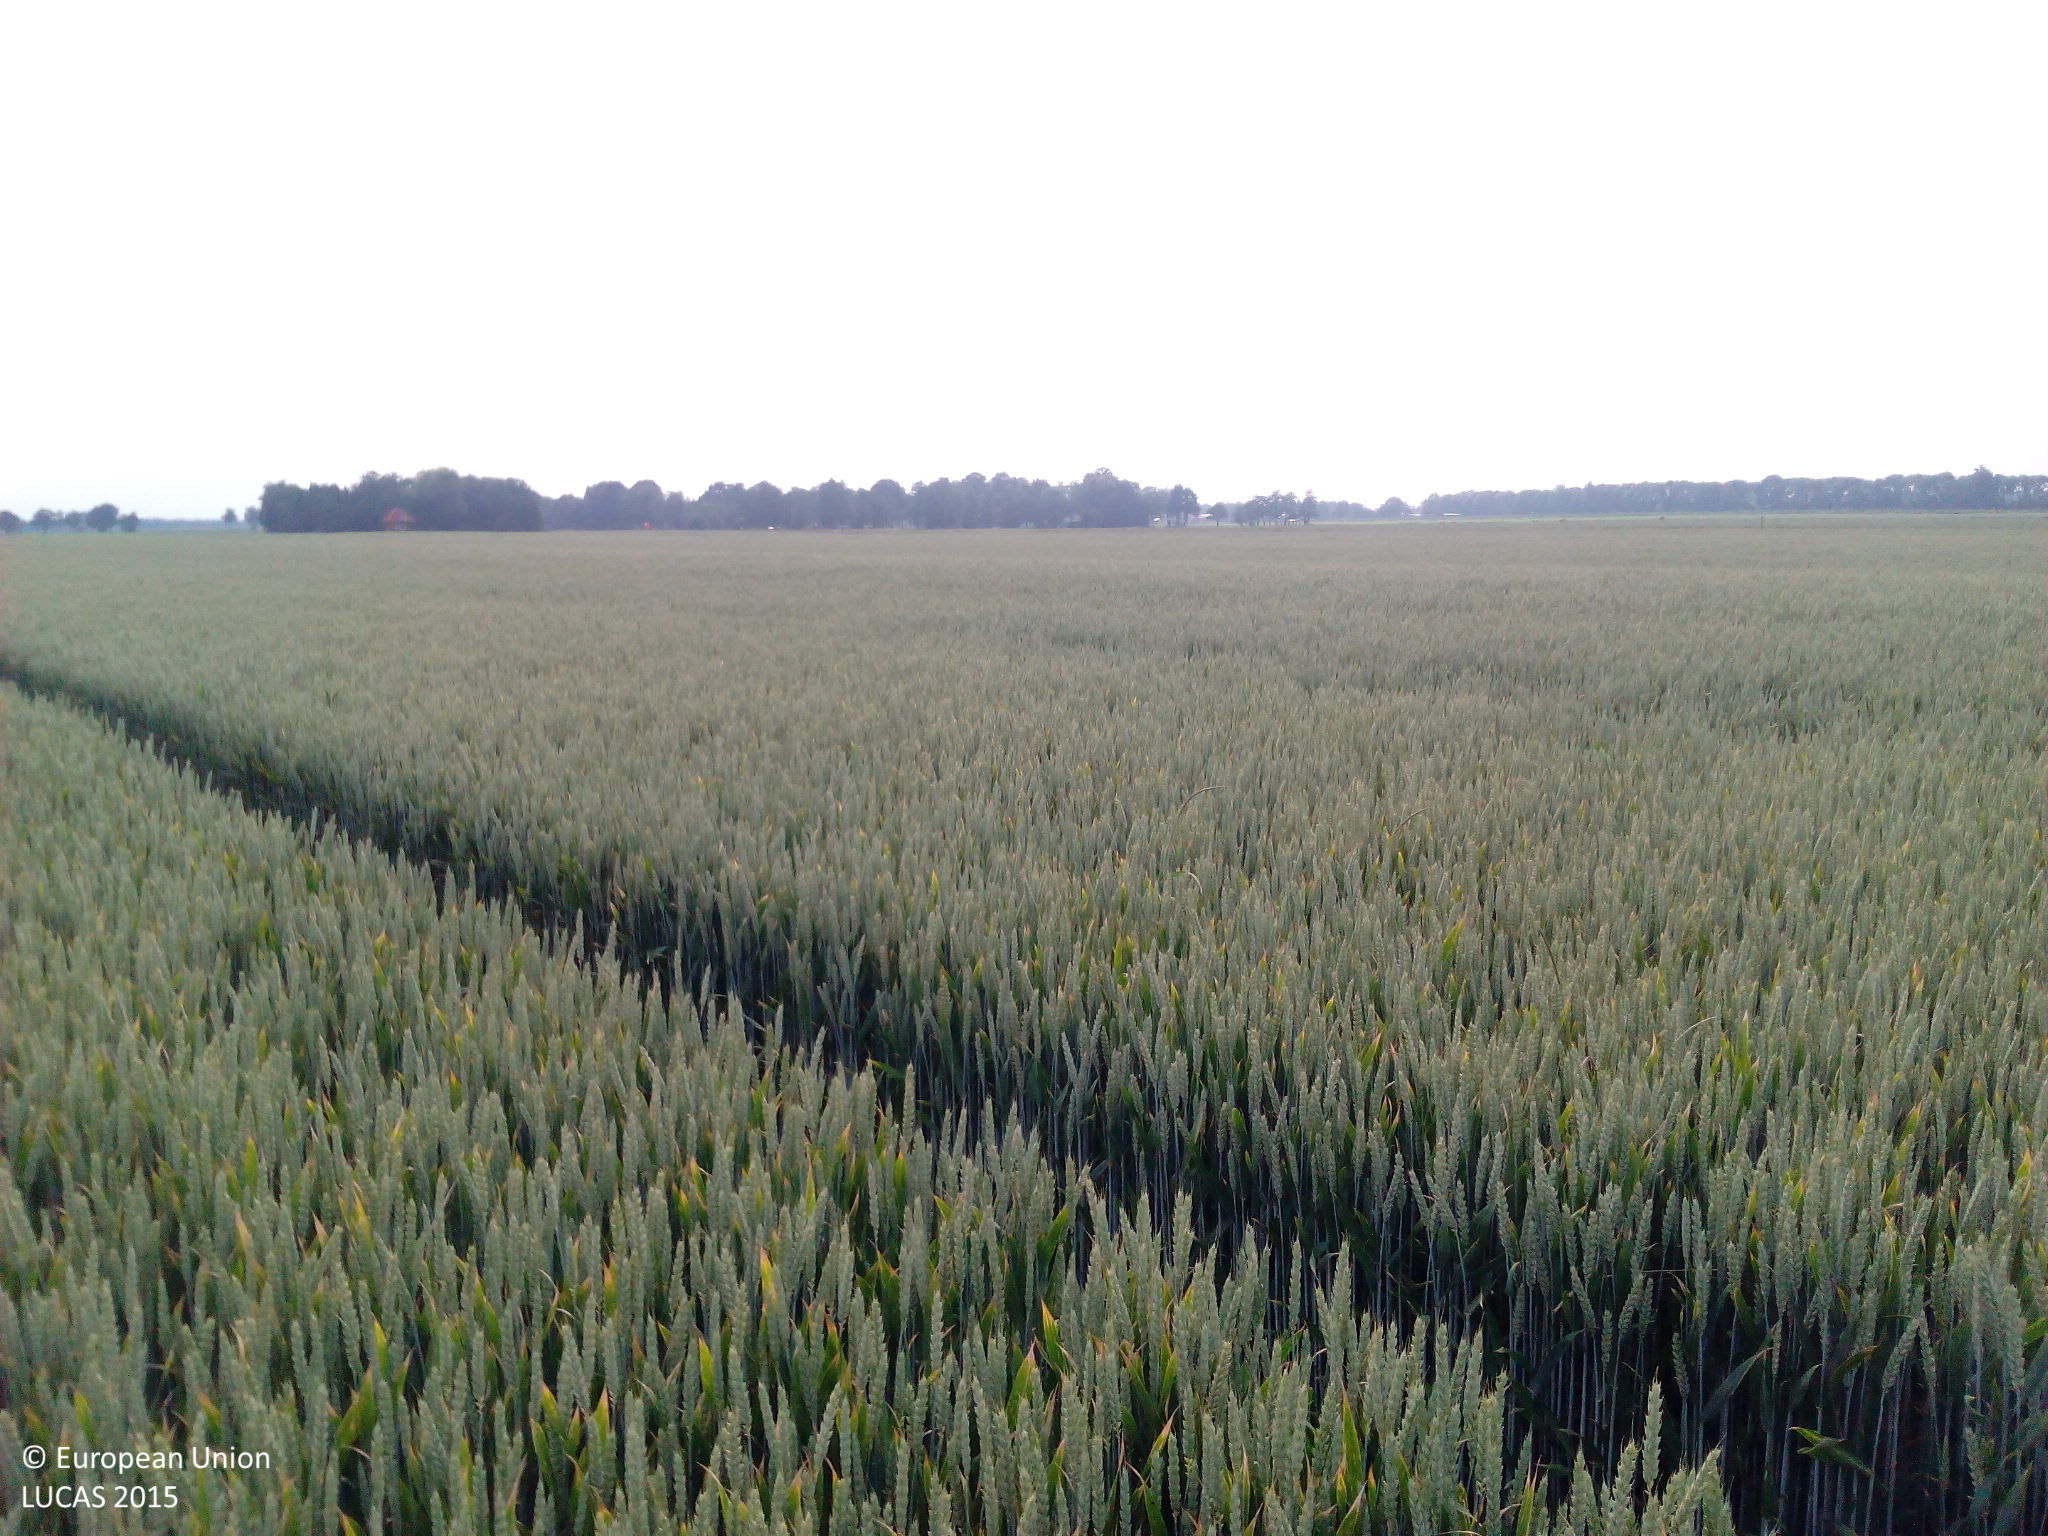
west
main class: Cropland
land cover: Common wheat
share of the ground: > 75 %
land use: Agriculture (excluding fallow land and kitchen gardens)
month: June
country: DE
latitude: 53.7415
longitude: 9.3181
